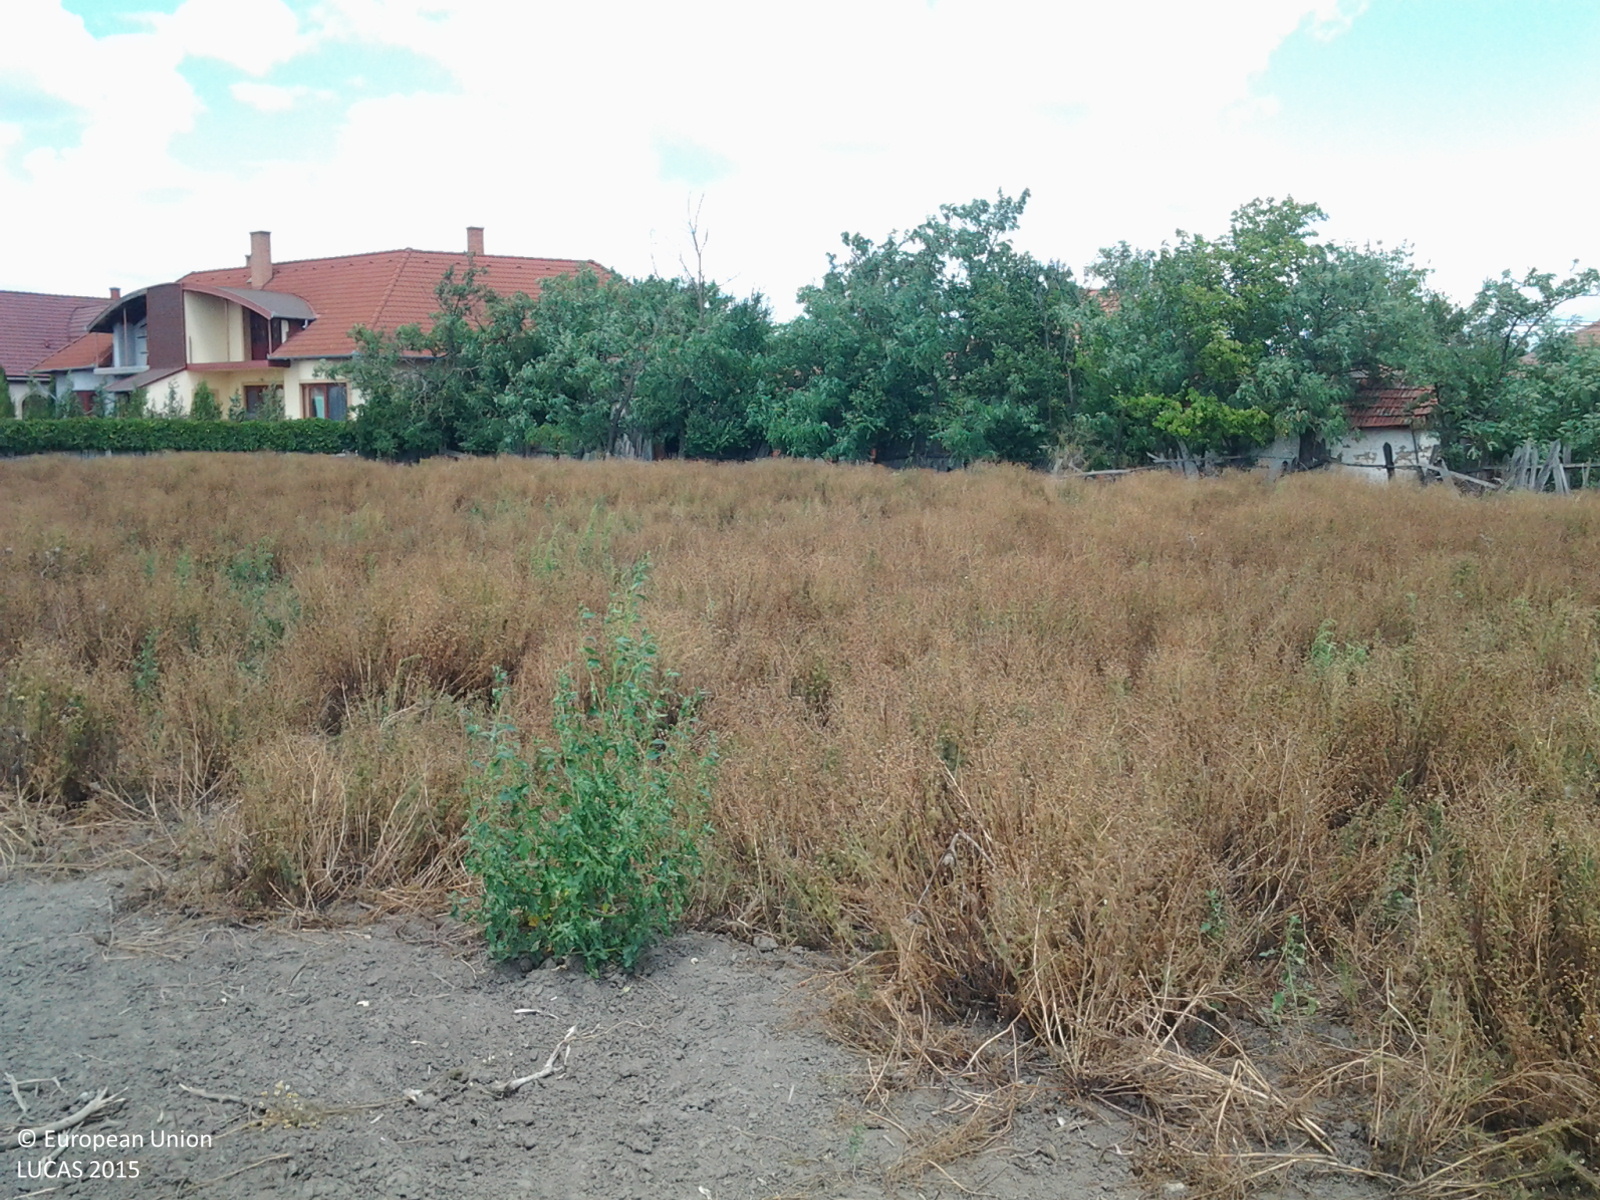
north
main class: Grassland
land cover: Spontaneously vegetated surfaces
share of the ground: > 75 %
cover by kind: herbaceous plants 95 %, unconsolidated bare surface 5 %
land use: Fallow land
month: July
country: HU
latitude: 47.2911
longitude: 20.2489
